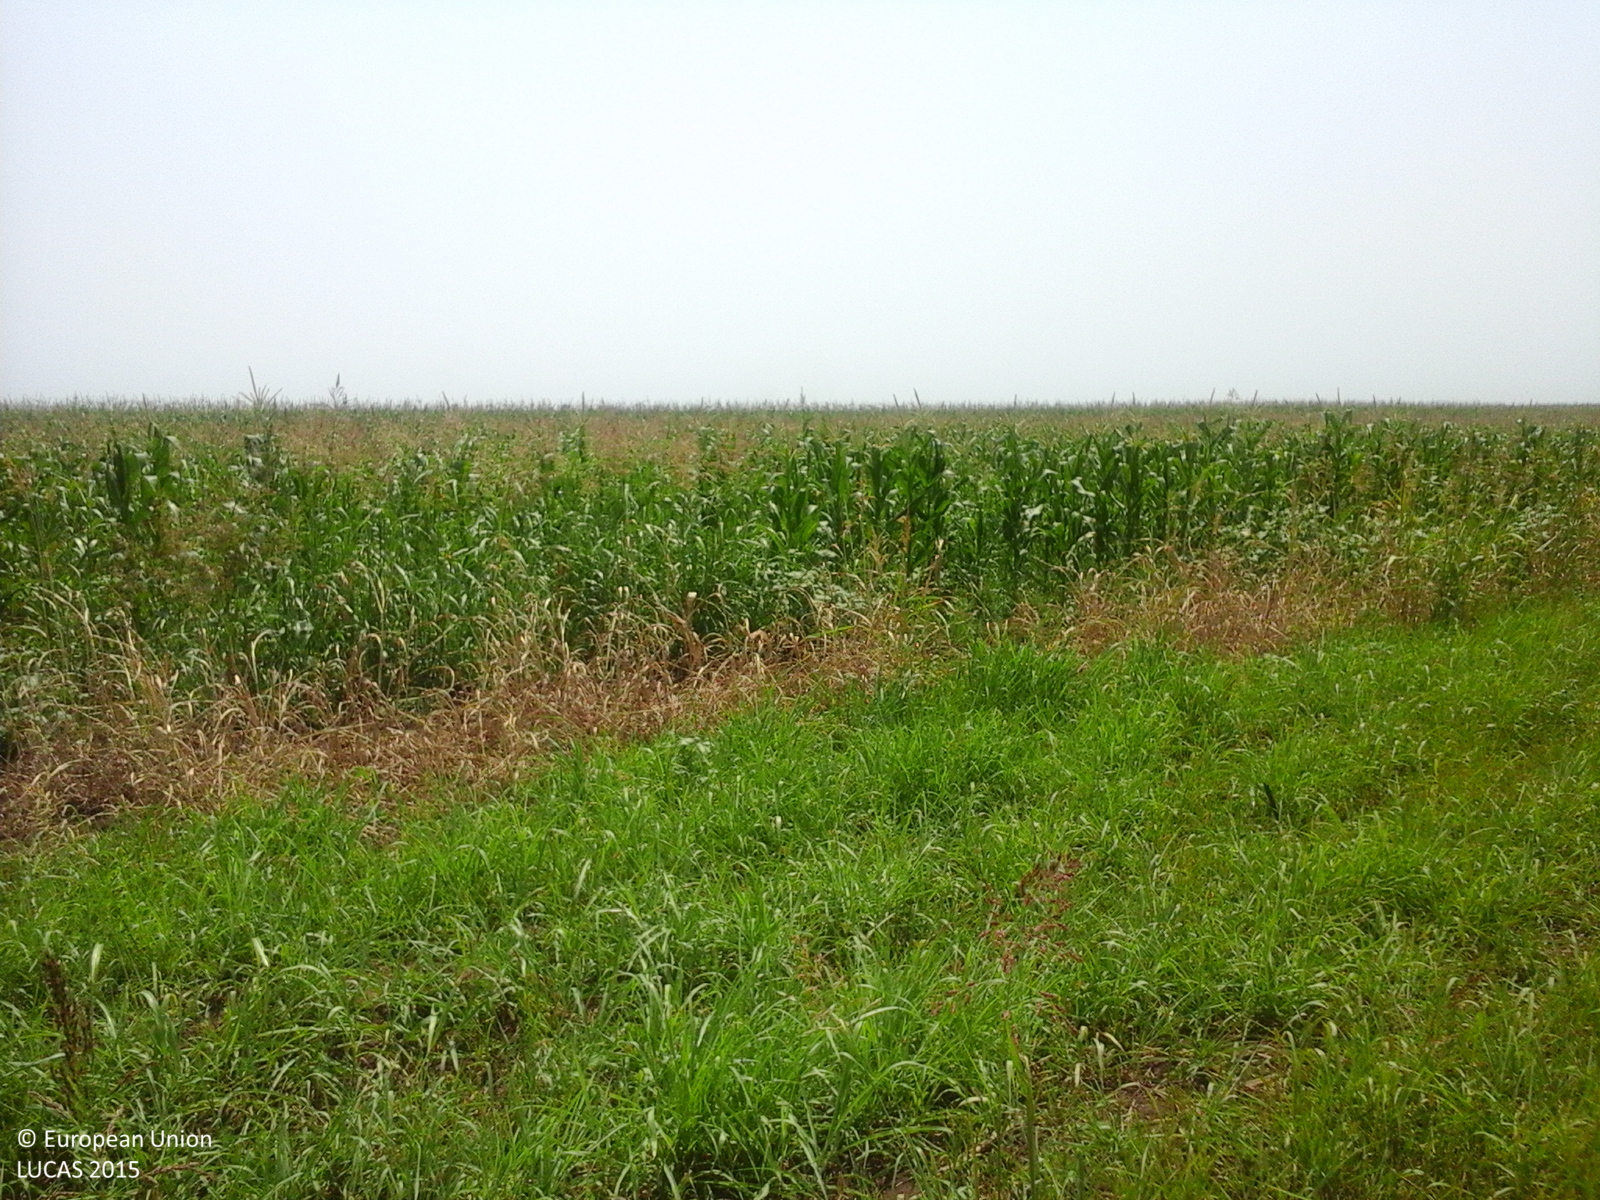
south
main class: Grassland
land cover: Grassland without tree/shrub cover
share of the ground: > 75 %
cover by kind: herbaceous plants 100 %
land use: Agriculture (excluding fallow land and kitchen gardens)
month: July
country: RO
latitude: 44.8530
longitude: 26.6357
